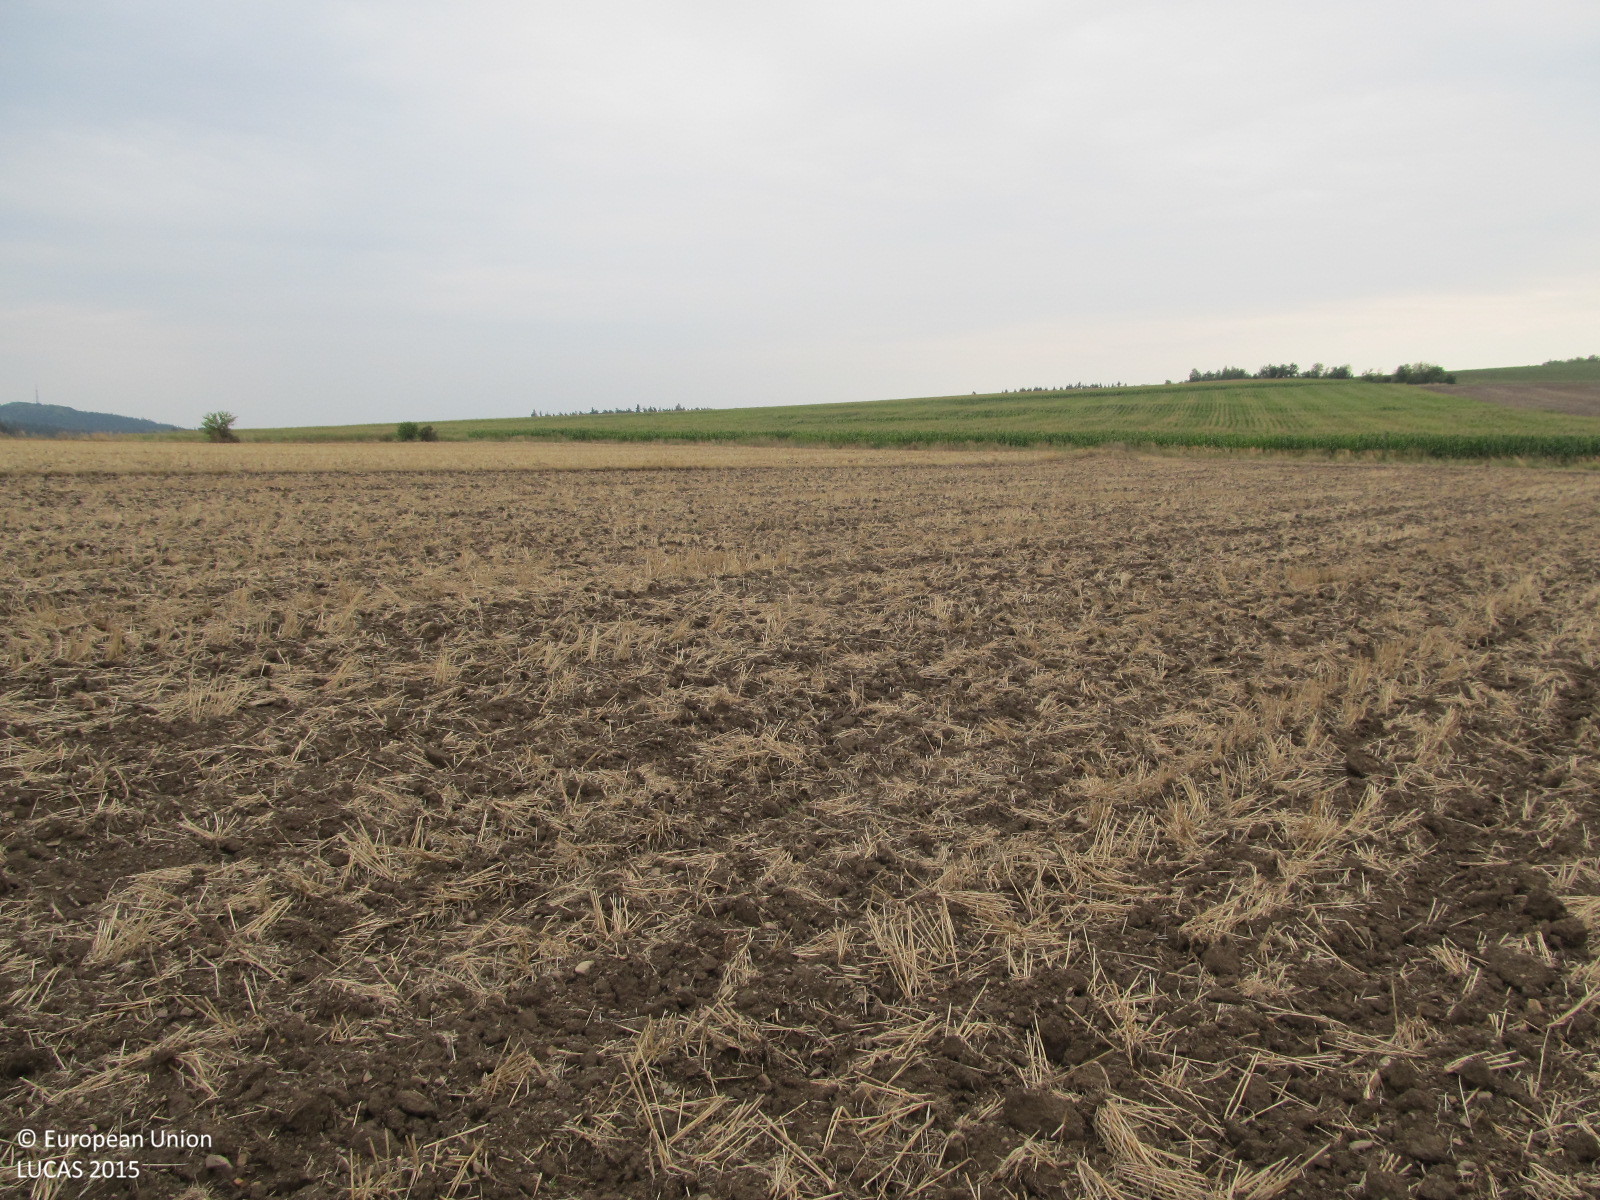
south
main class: Cropland
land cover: Barley
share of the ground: < 10 %
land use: Agriculture (excluding fallow land and kitchen gardens)
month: August
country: AT
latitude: 48.8605
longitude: 15.5237
